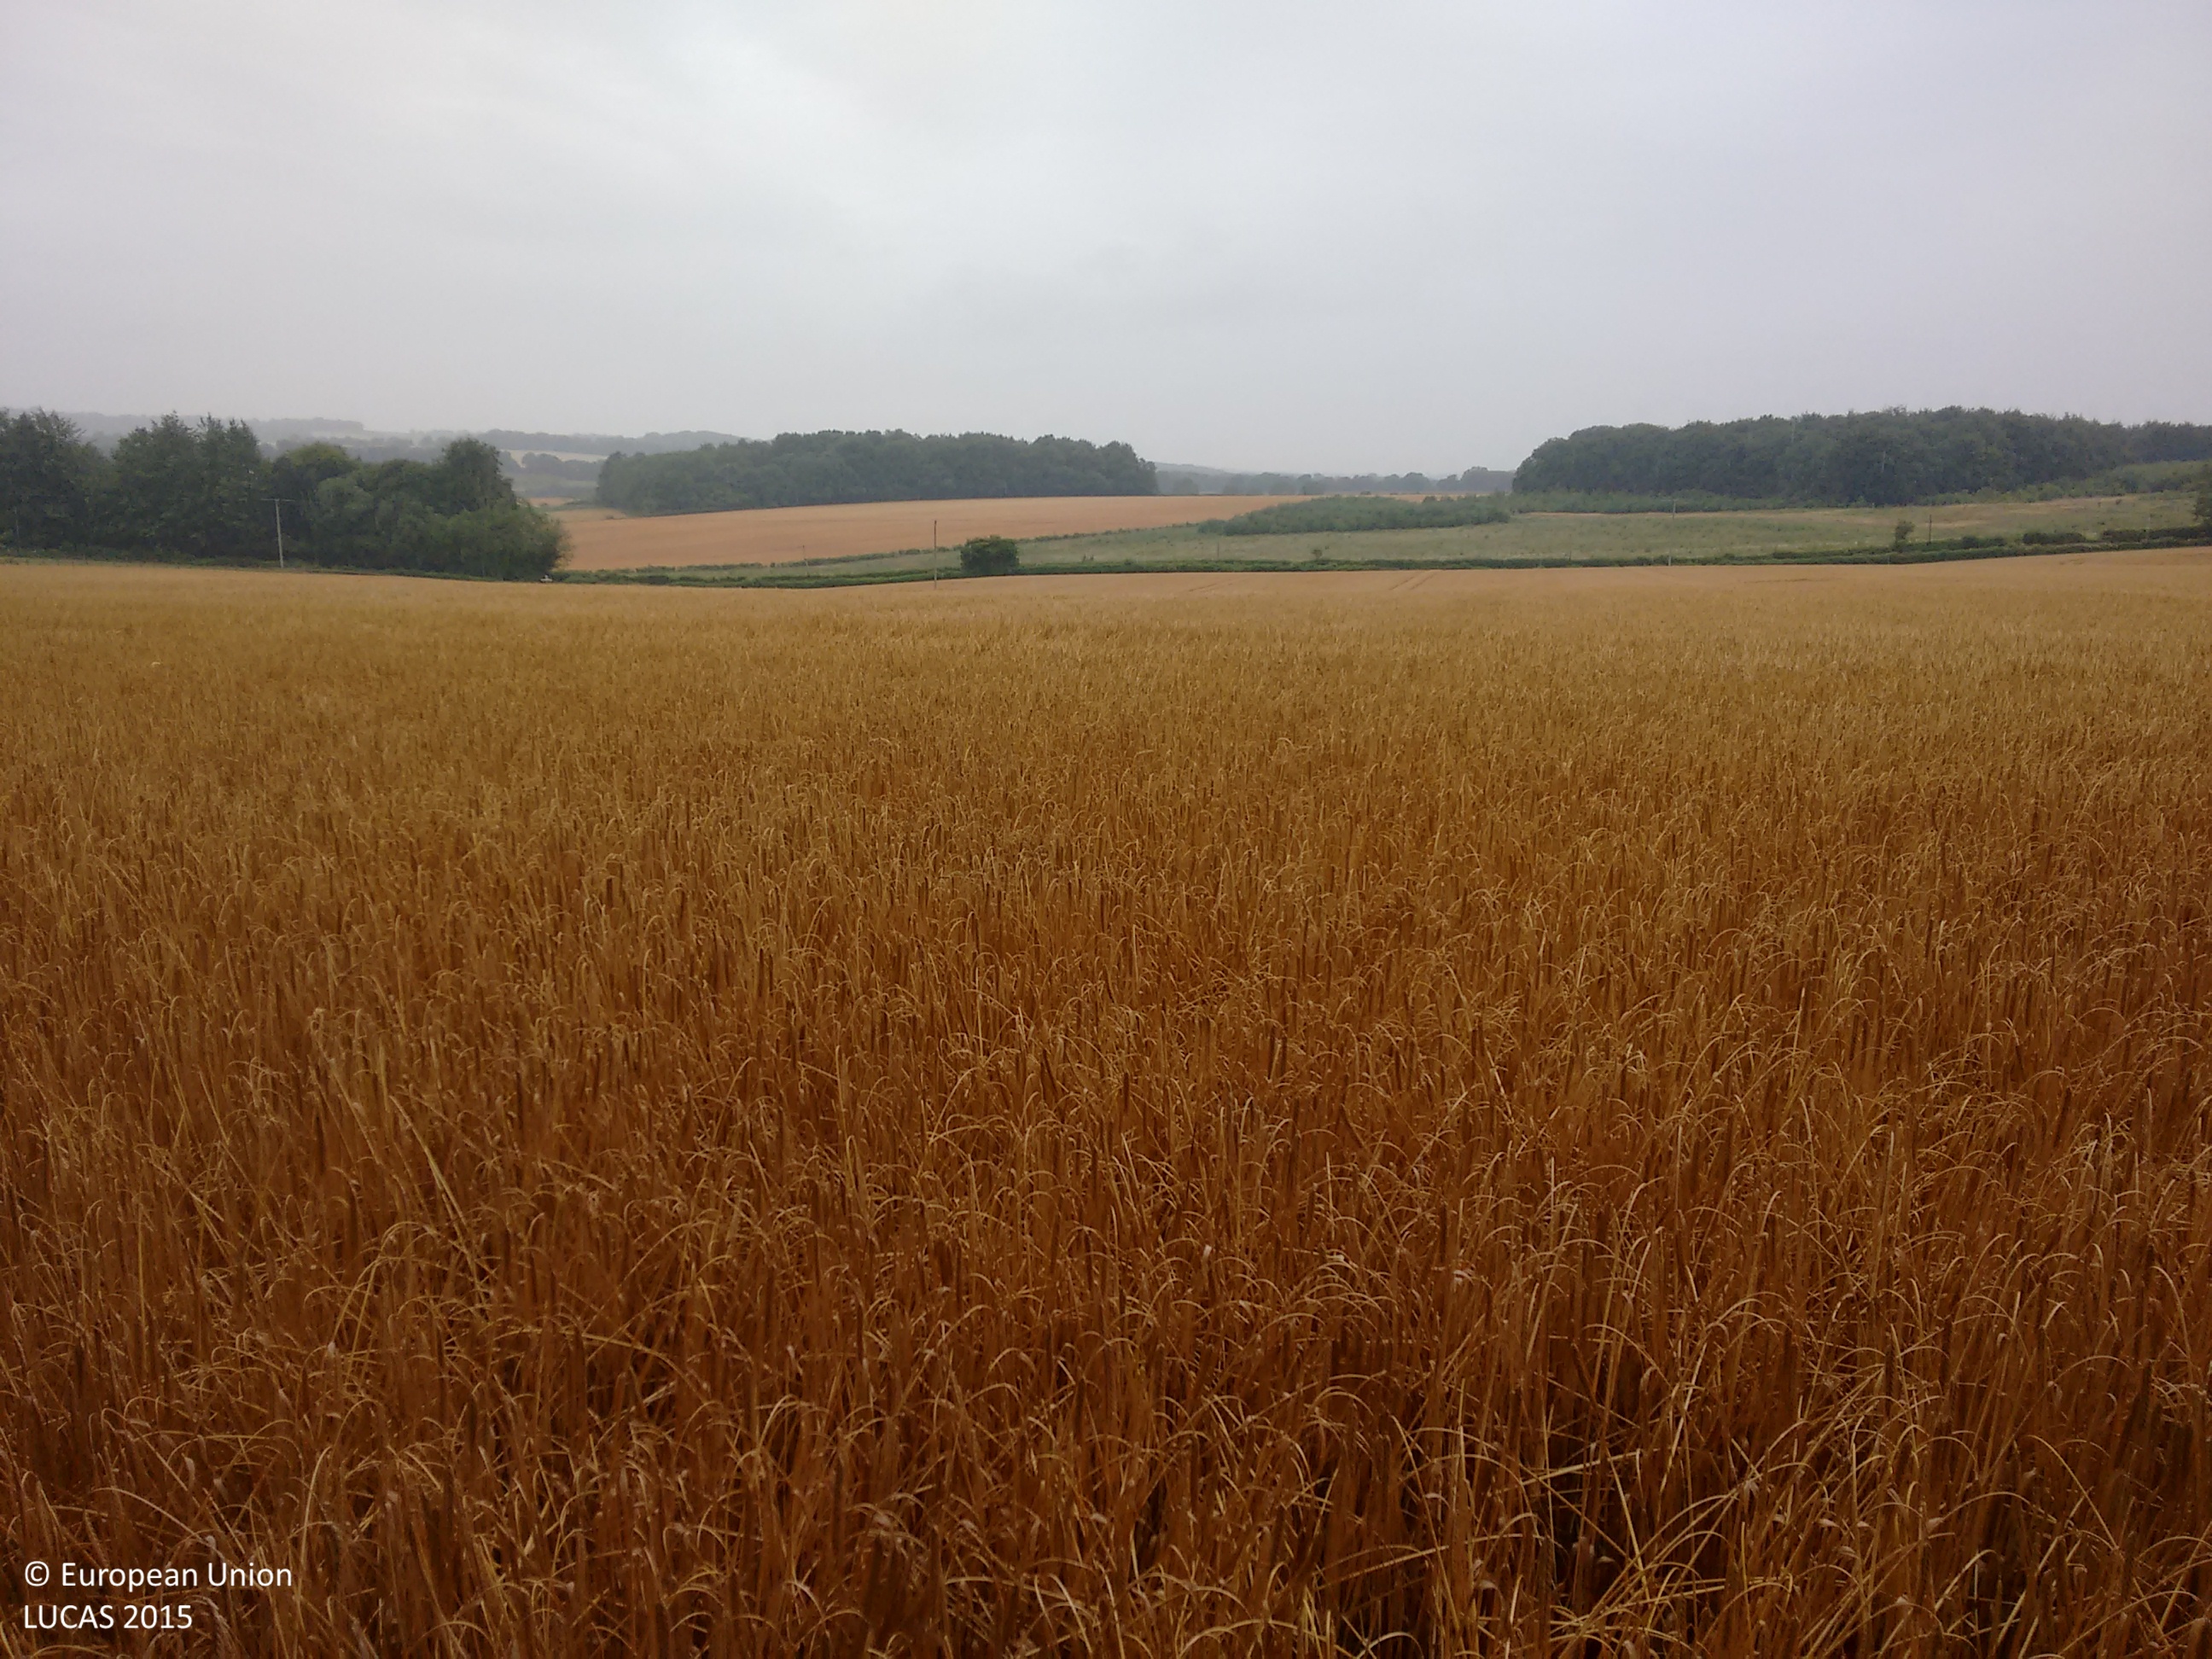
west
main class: Cropland
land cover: Barley
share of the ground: > 75 %
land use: Agriculture (excluding fallow land and kitchen gardens)
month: July
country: GB
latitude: 51.0207
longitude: -1.0940
